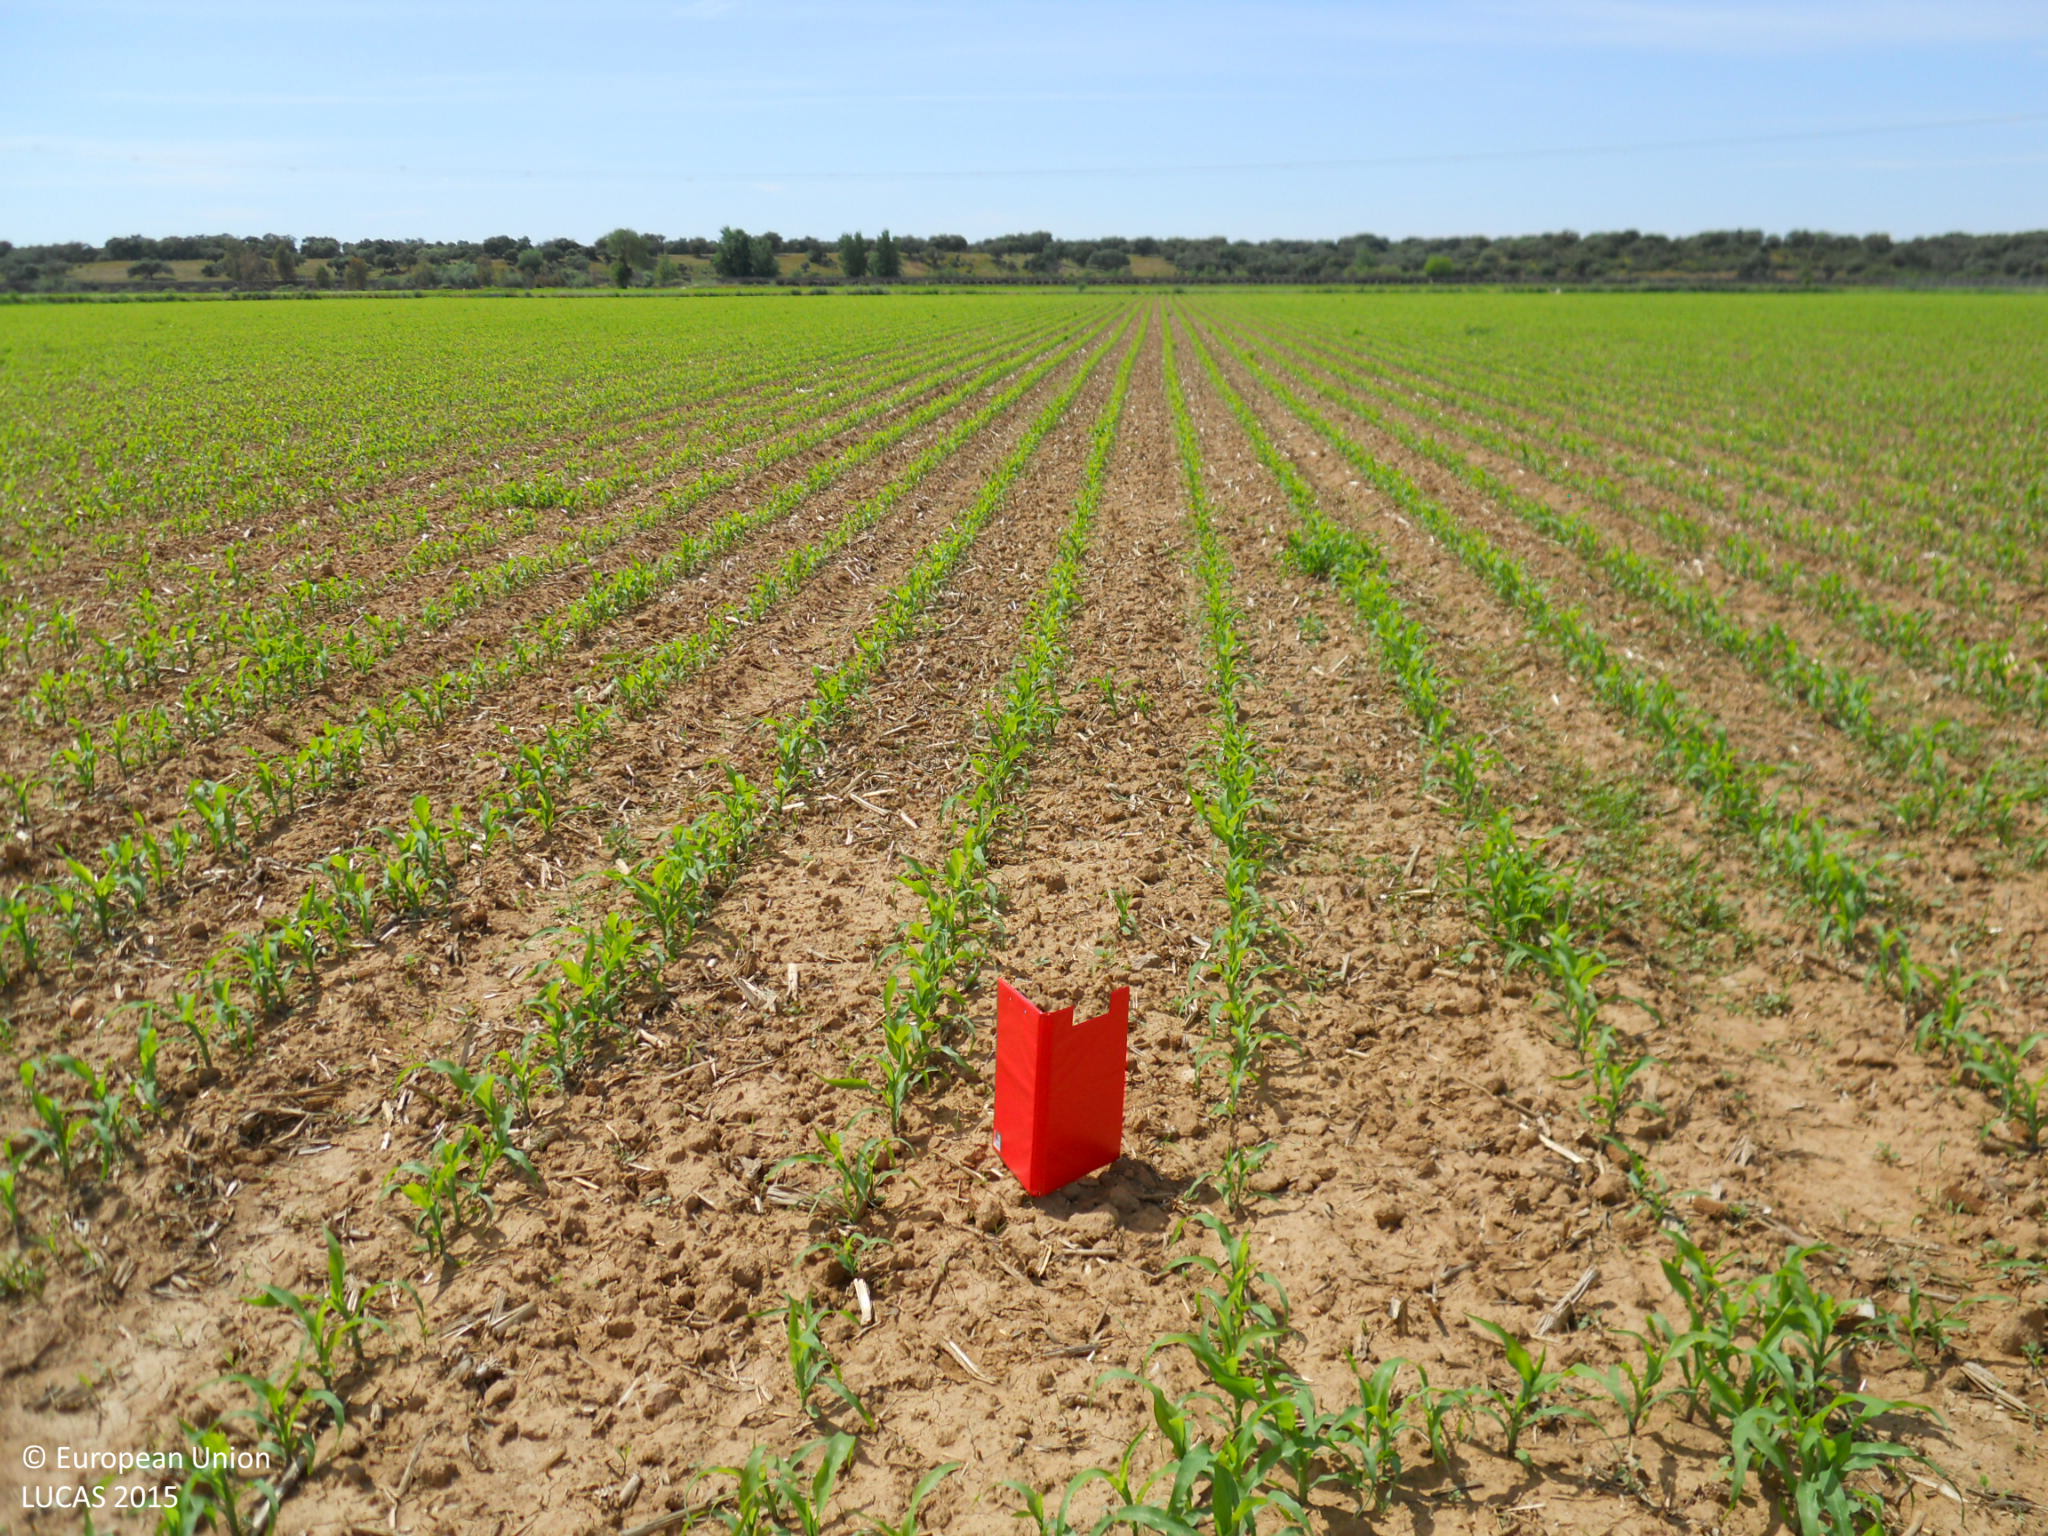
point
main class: Cropland
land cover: Maize
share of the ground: 10 - 25 %
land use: Agriculture (excluding fallow land and kitchen gardens)
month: April
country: ES
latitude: 38.9678
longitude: -6.9327
